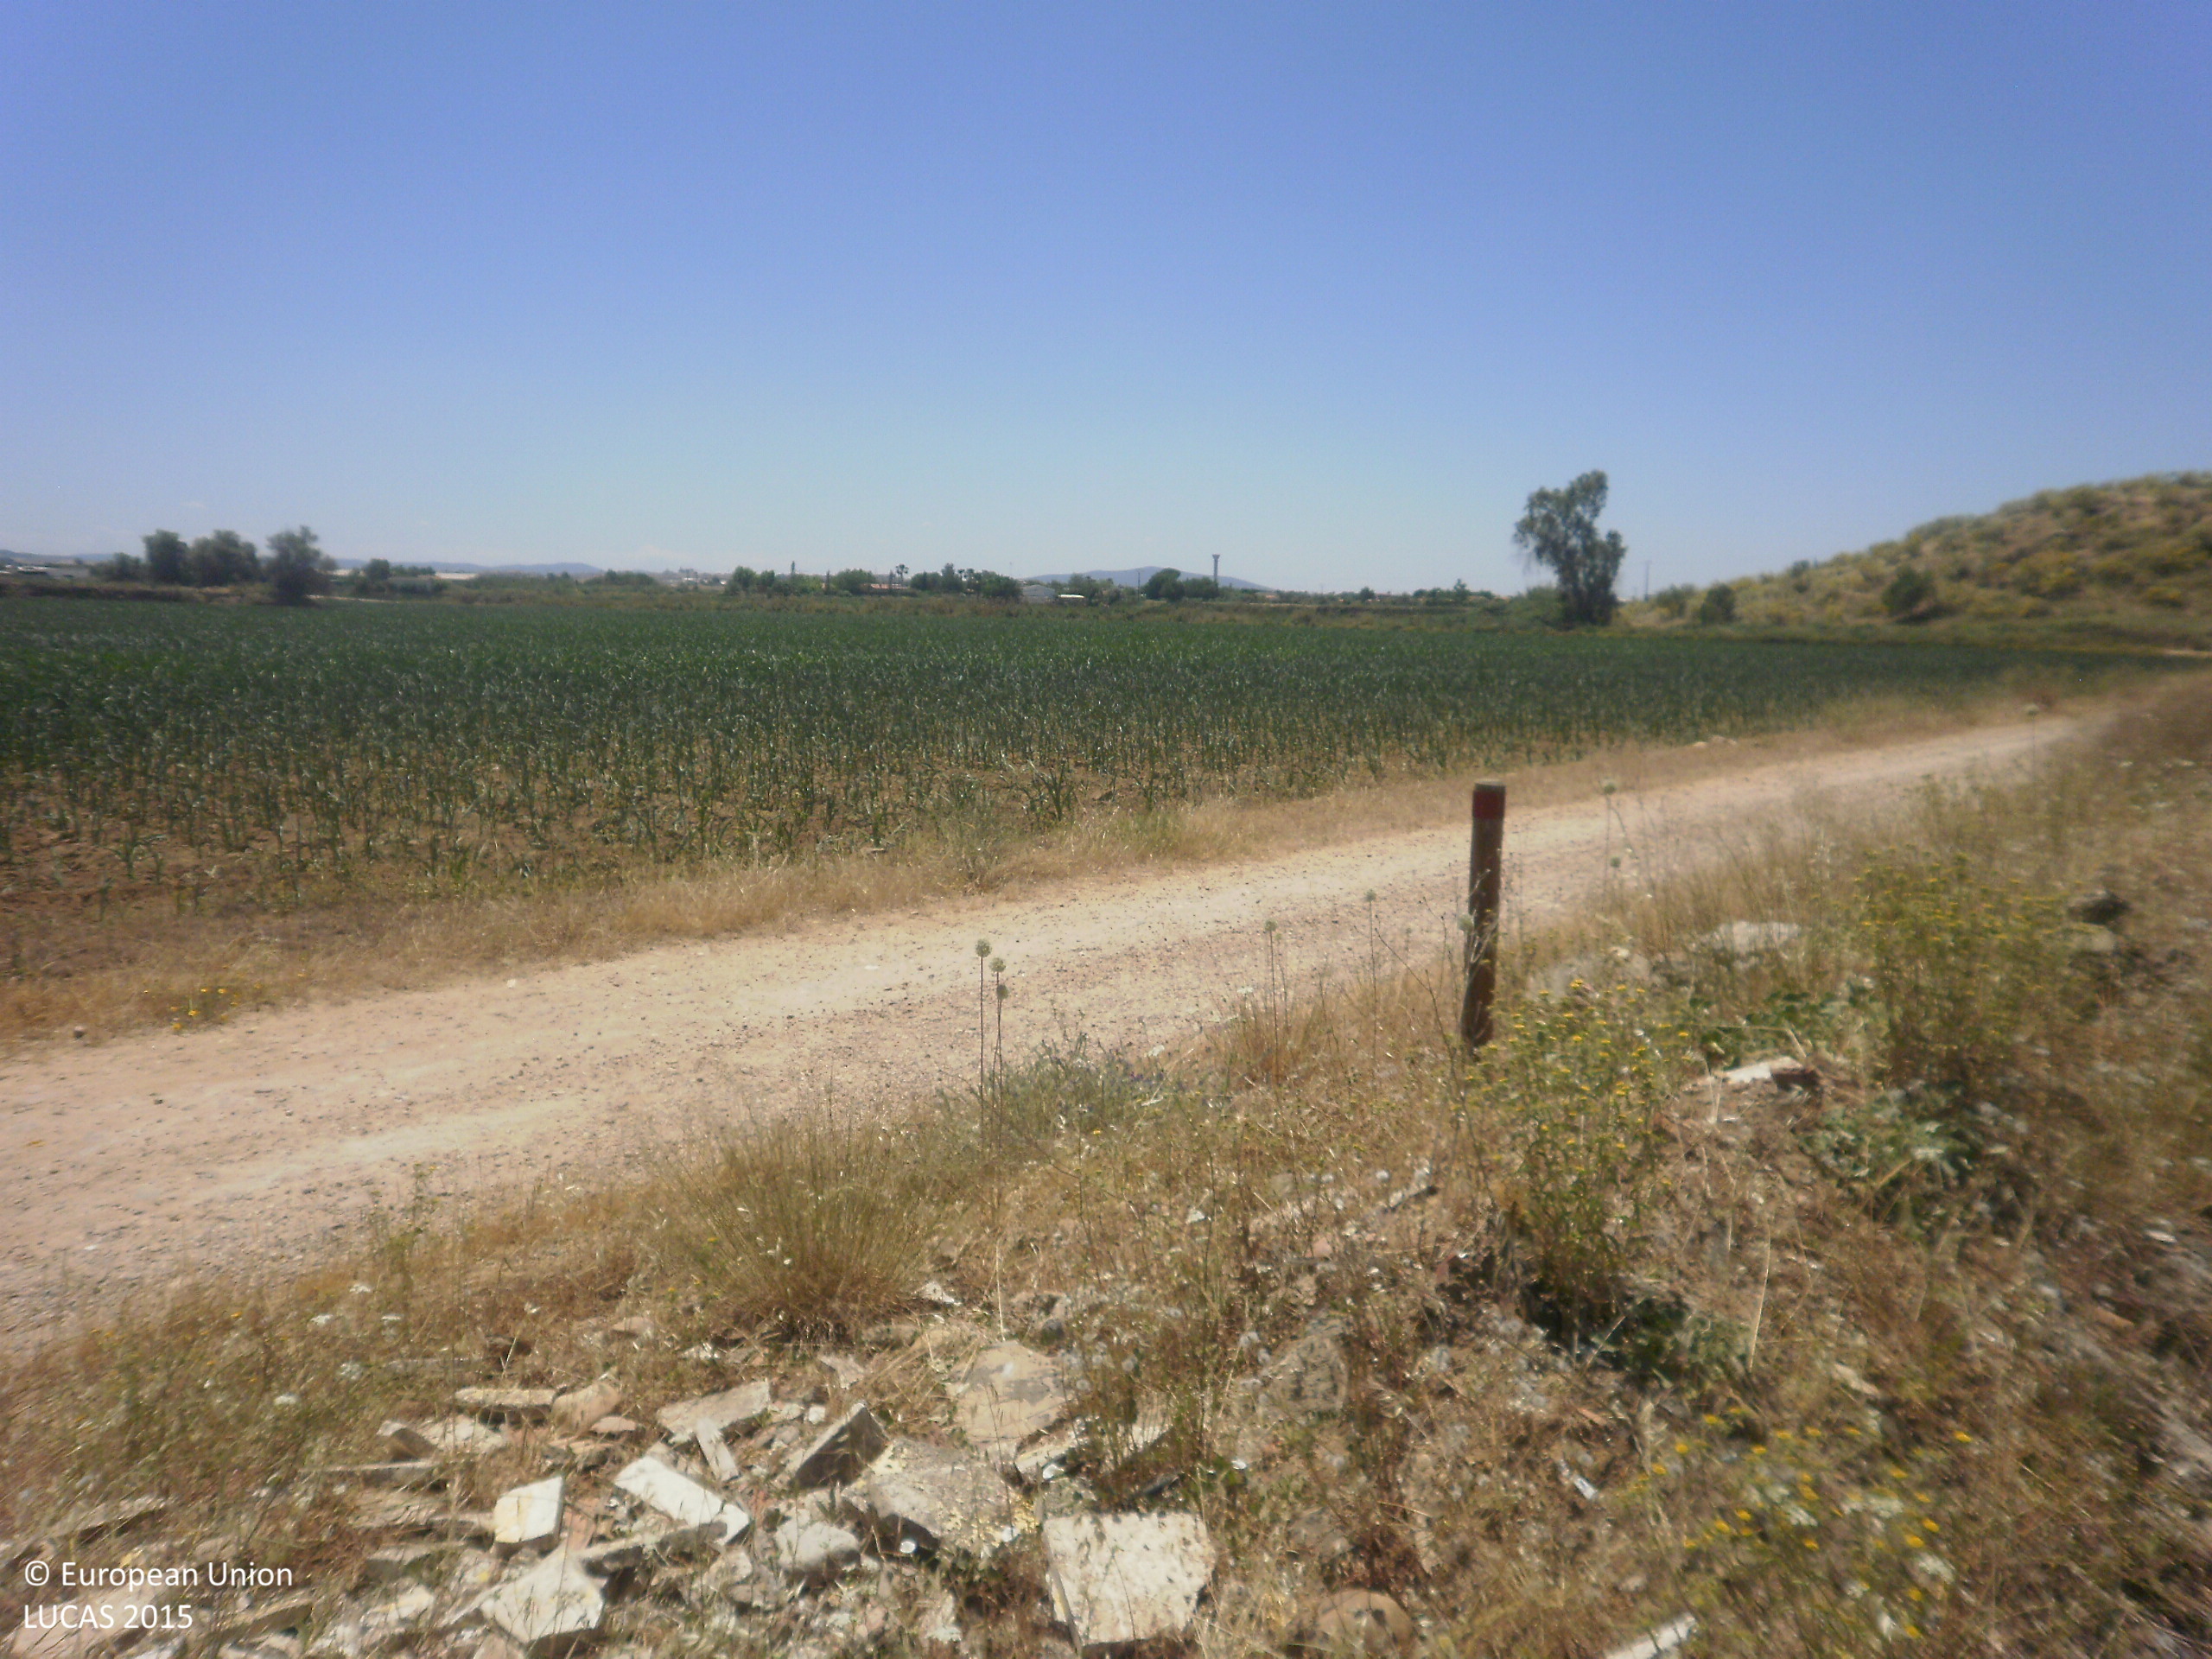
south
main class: Shrubland
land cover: Shrubland without tree cover
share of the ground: 25 - 50 %
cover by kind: herbaceous plants 70 %, shrubs 30 %
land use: Mining and quarrying
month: May
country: ES
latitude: 39.0163
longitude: -5.7908
